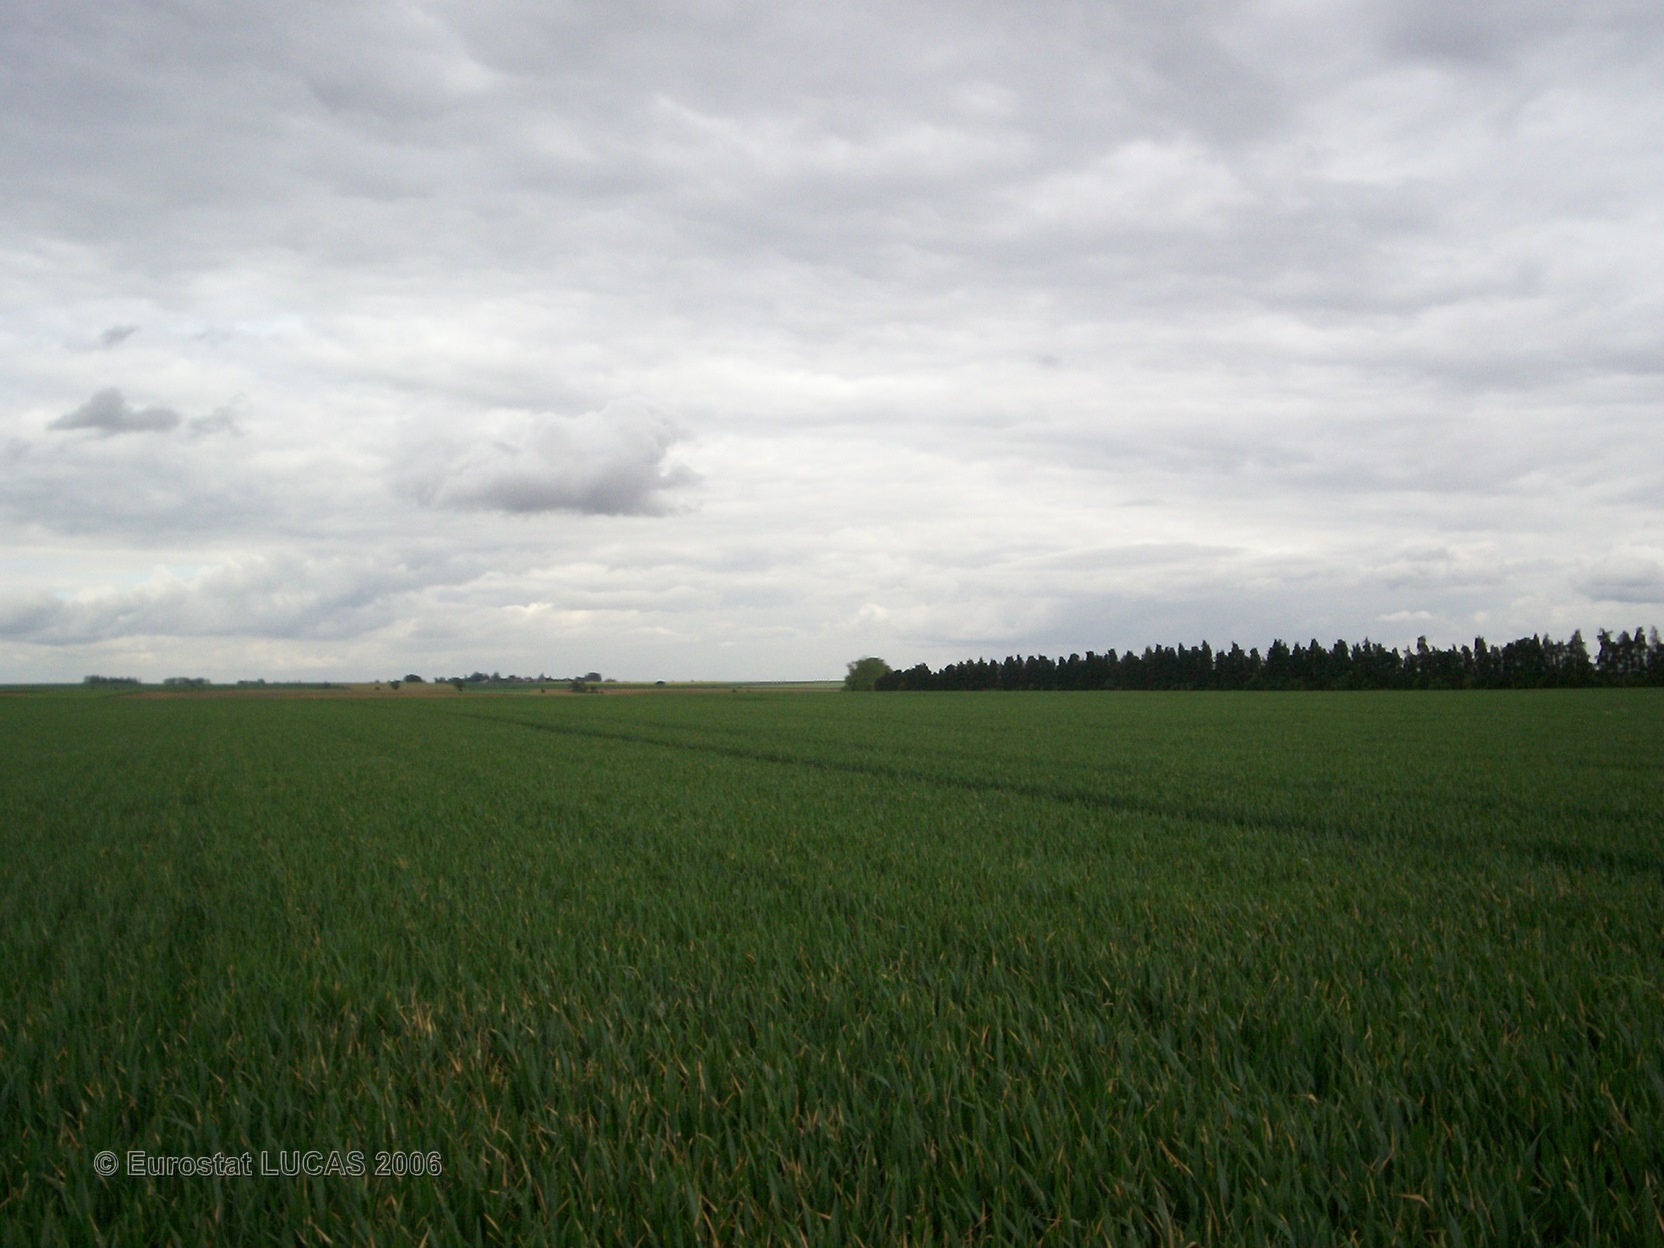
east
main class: Cropland
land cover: Common wheat
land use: Agriculture (excluding fallow land and kitchen gardens)
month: May
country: FR
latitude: 49.0881
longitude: 2.7736
